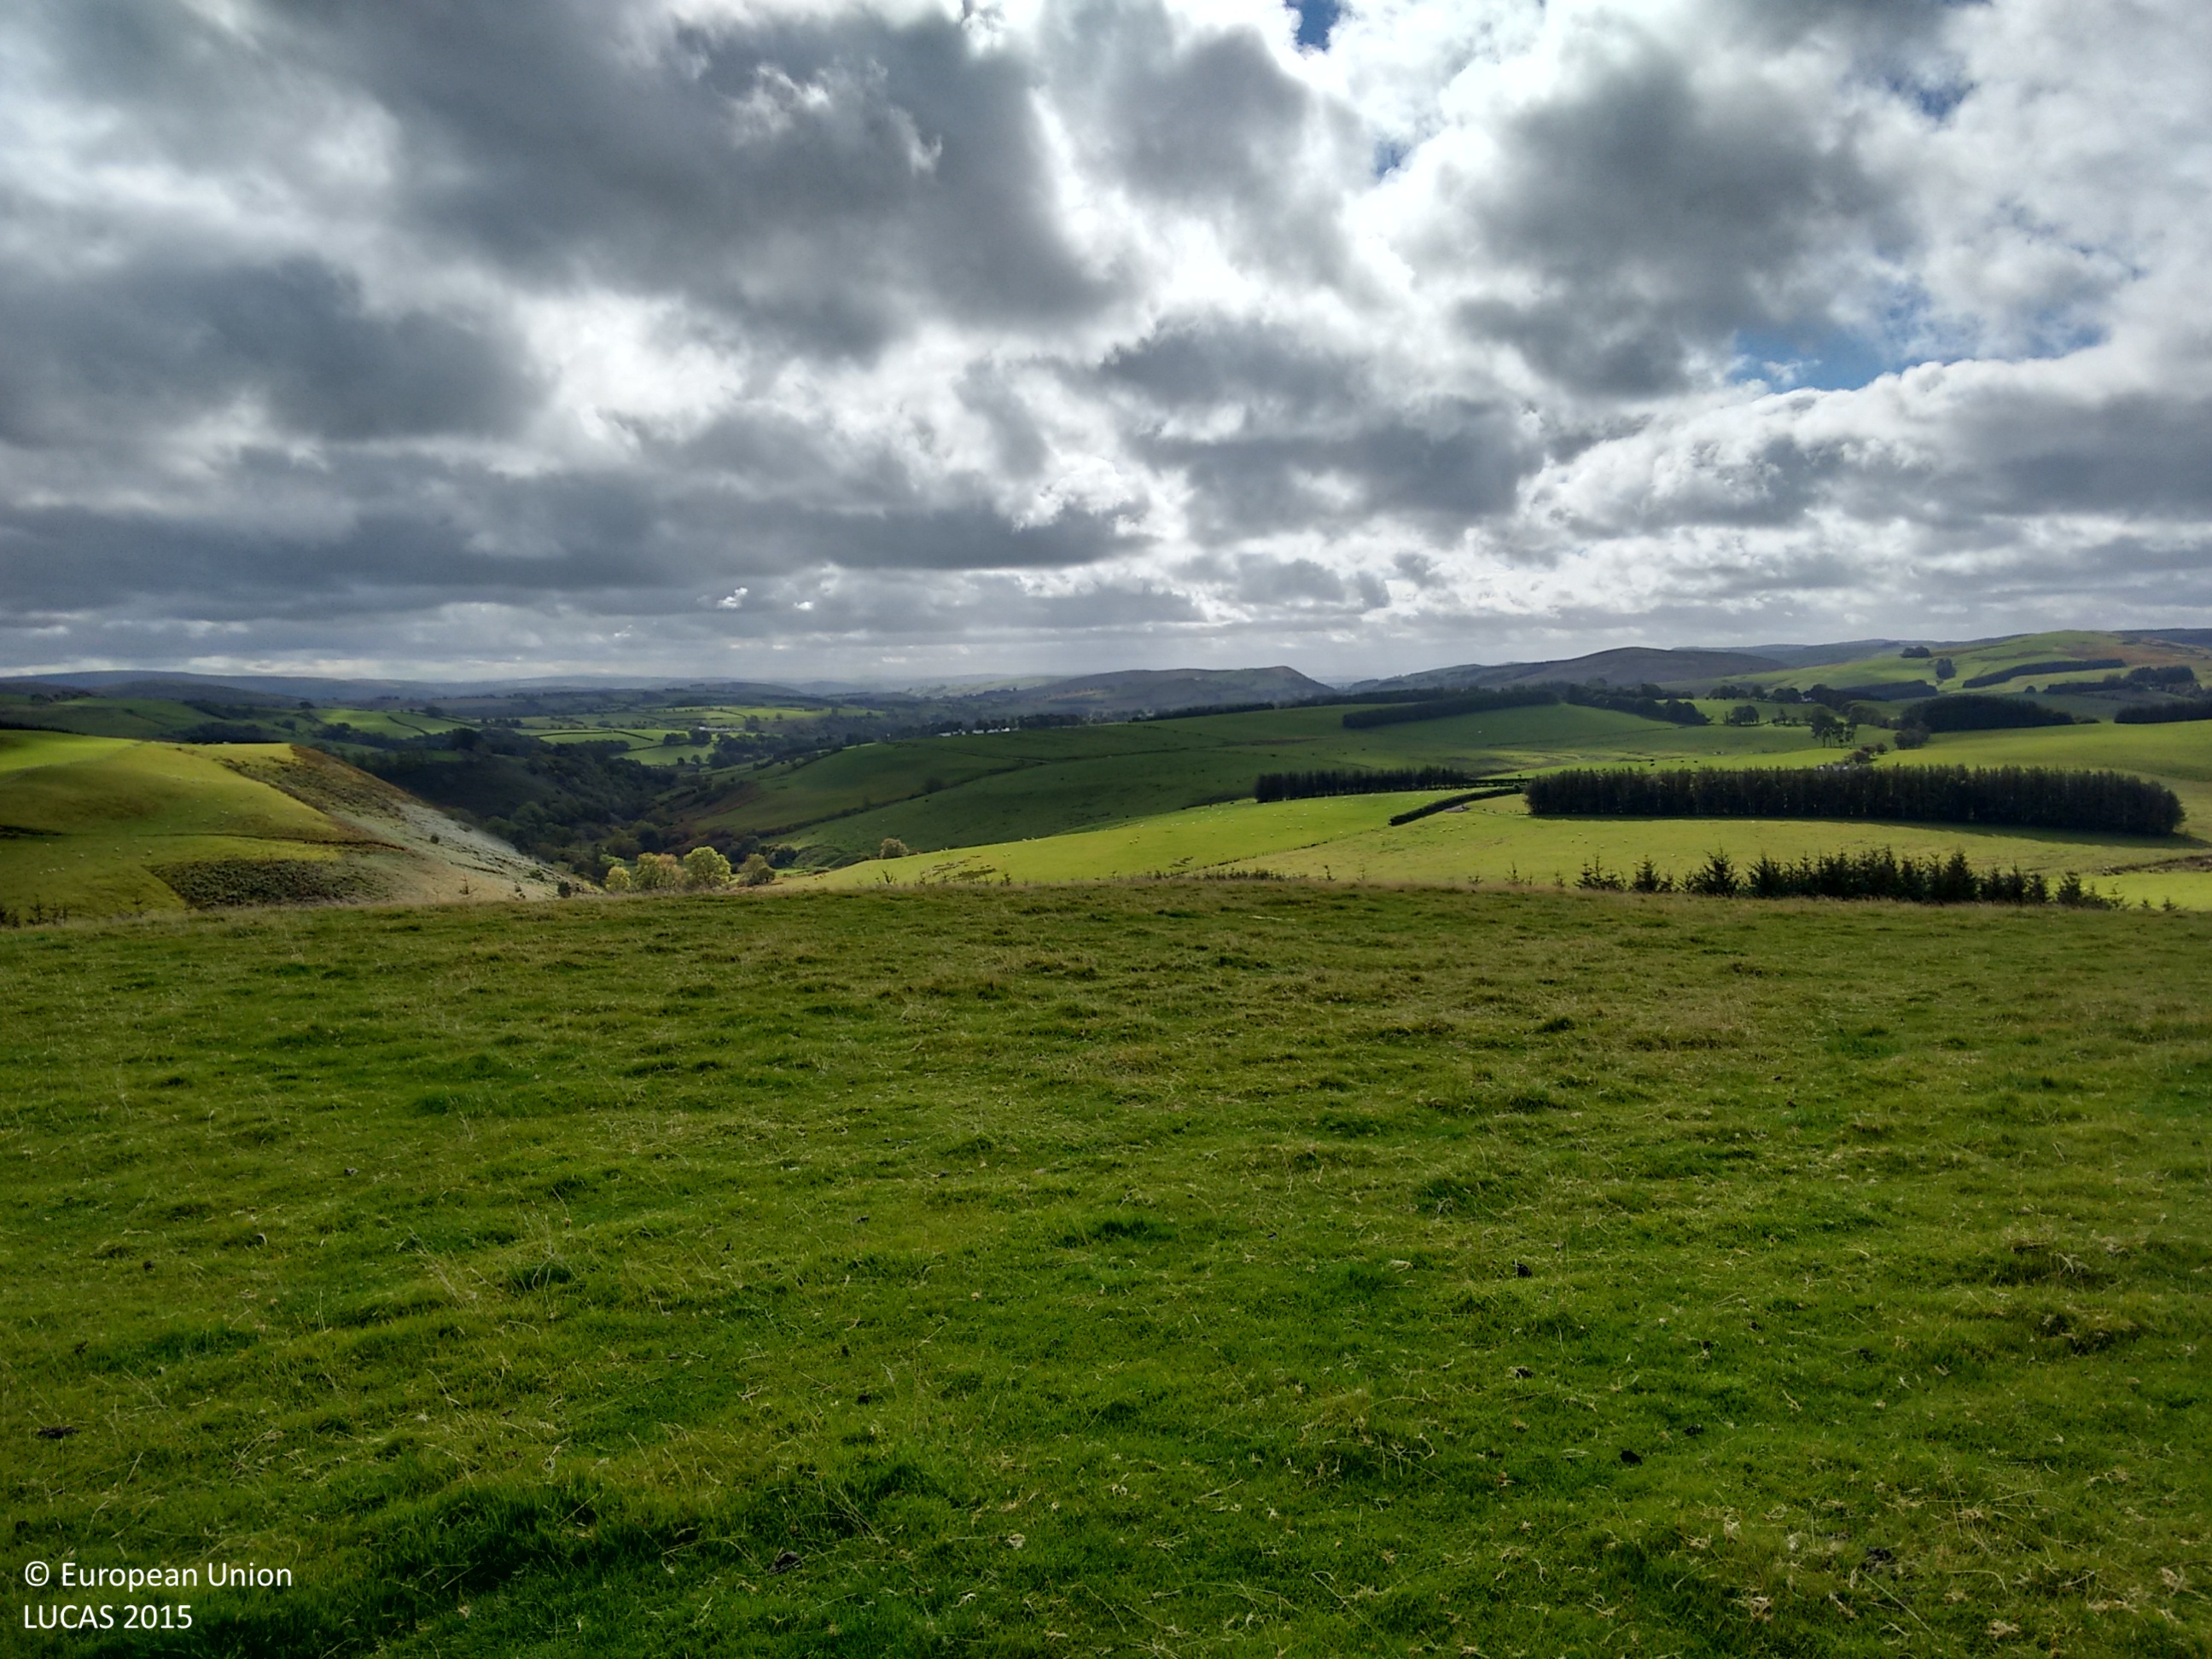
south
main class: Grassland
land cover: Grassland without tree/shrub cover
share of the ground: > 75 %
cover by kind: herbaceous plants 100 %
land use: Agriculture (excluding fallow land and kitchen gardens)
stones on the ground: < 10 %
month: October
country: GB
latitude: 52.4235
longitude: -3.3306
